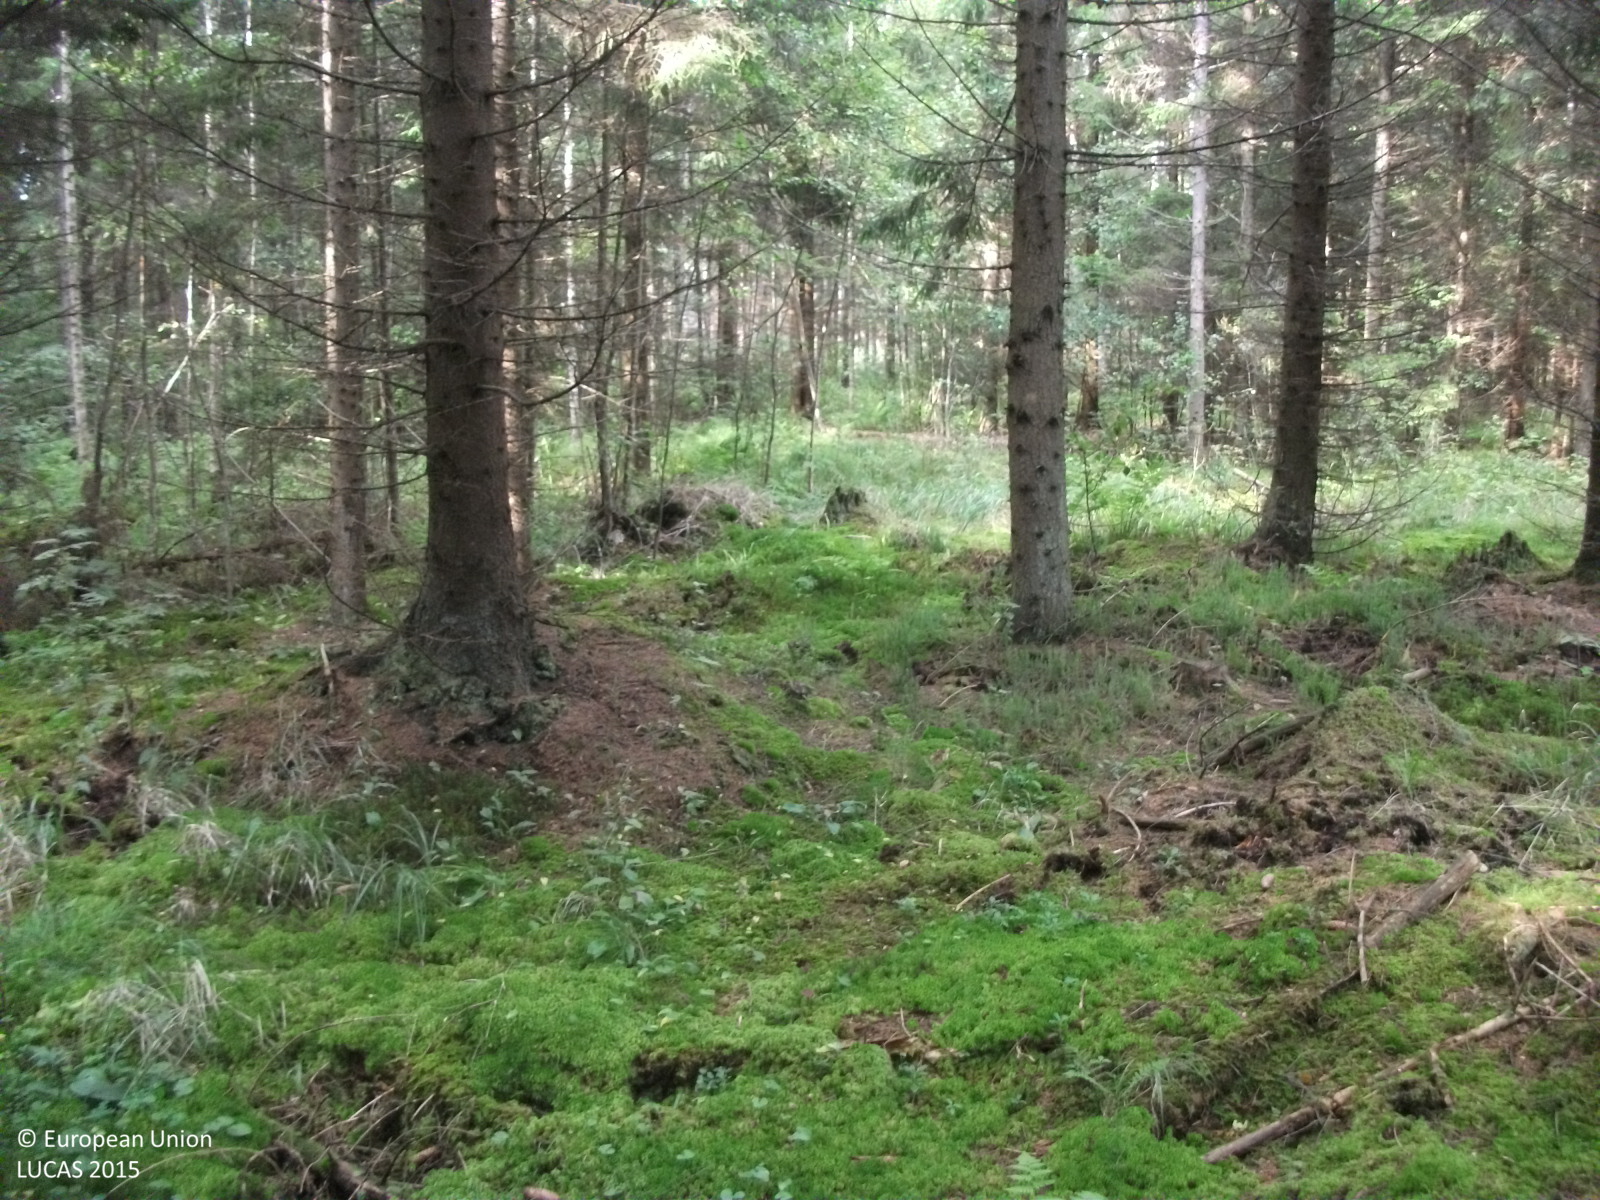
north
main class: Woodland
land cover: Spruce dominated coniferous woodland
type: hemiboreal forest and nemoral coniferous forest and mixed broadleaved-coniferous forest
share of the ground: > 75 %
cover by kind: coniferous forest trees 80 %, lichens and mosses 10 %, shrubs 5 %, herbaceous plants 5 %
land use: Forestry
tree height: > 5 m
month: September
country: LV
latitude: 57.5823
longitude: 24.4221
